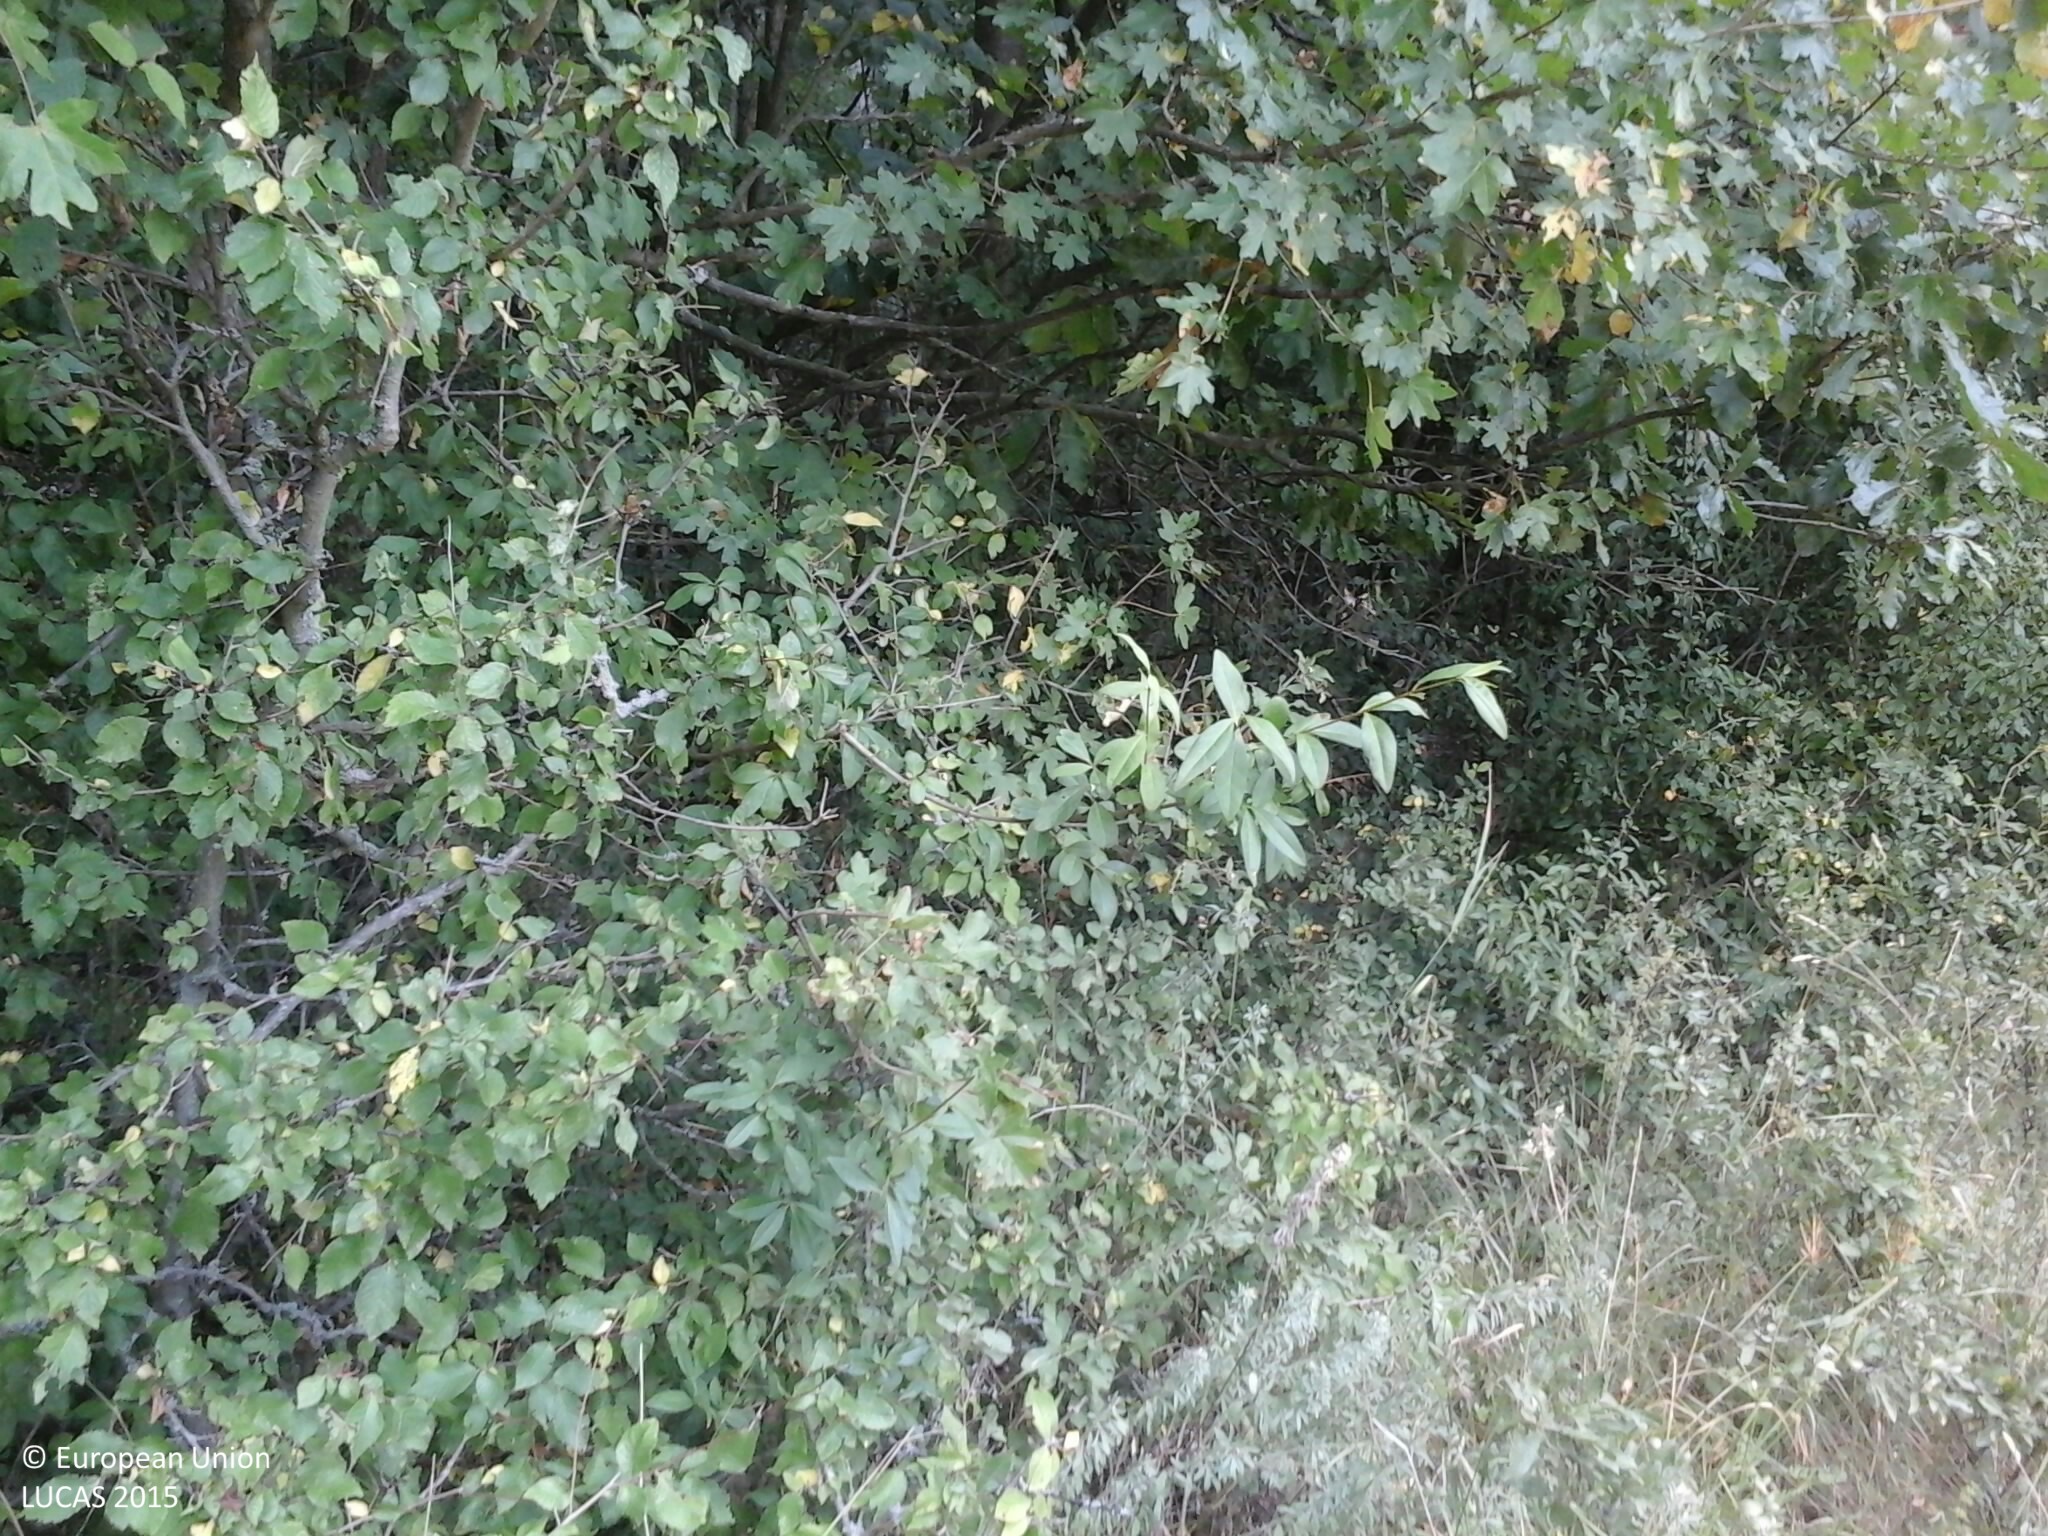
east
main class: Woodland
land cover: Broadleaved woodland
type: mesophytic deciduous forest
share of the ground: > 75 %
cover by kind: broadleaved forest trees 100 %
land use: Forestry
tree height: > 5 m
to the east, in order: Broadleaved woodland
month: July
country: HU
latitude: 47.9184
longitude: 19.3217
